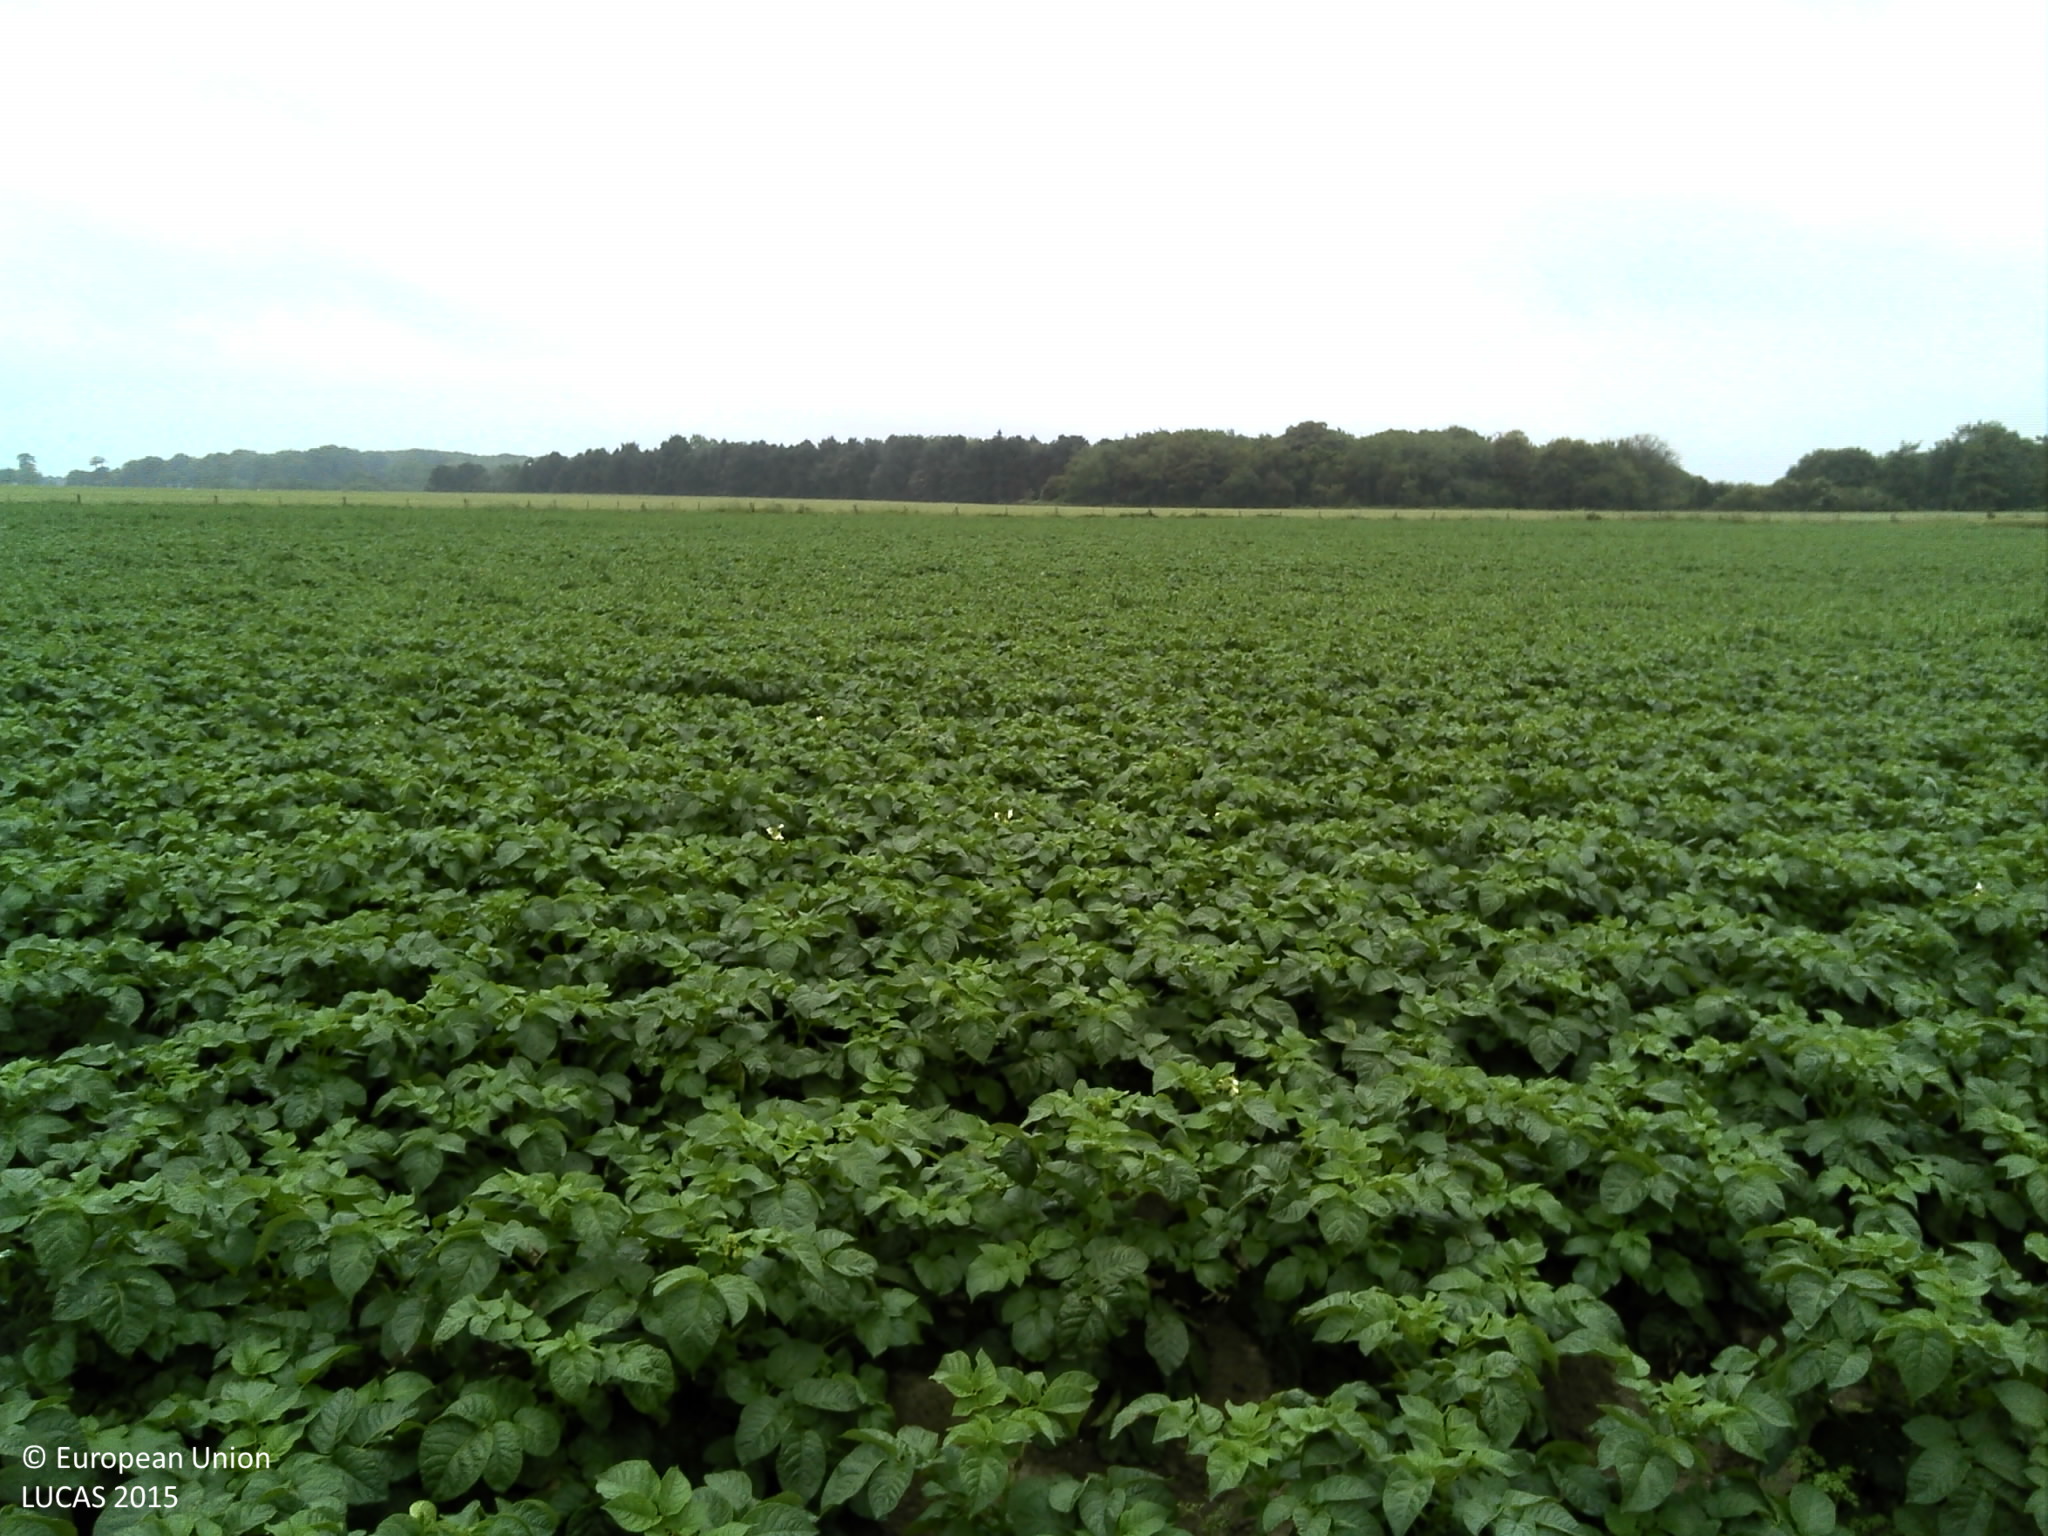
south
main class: Cropland
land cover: Potatoes
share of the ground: > 75 %
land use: Agriculture (excluding fallow land and kitchen gardens)
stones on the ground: < 10 %
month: June
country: FR
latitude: 49.7336
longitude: 0.3007
